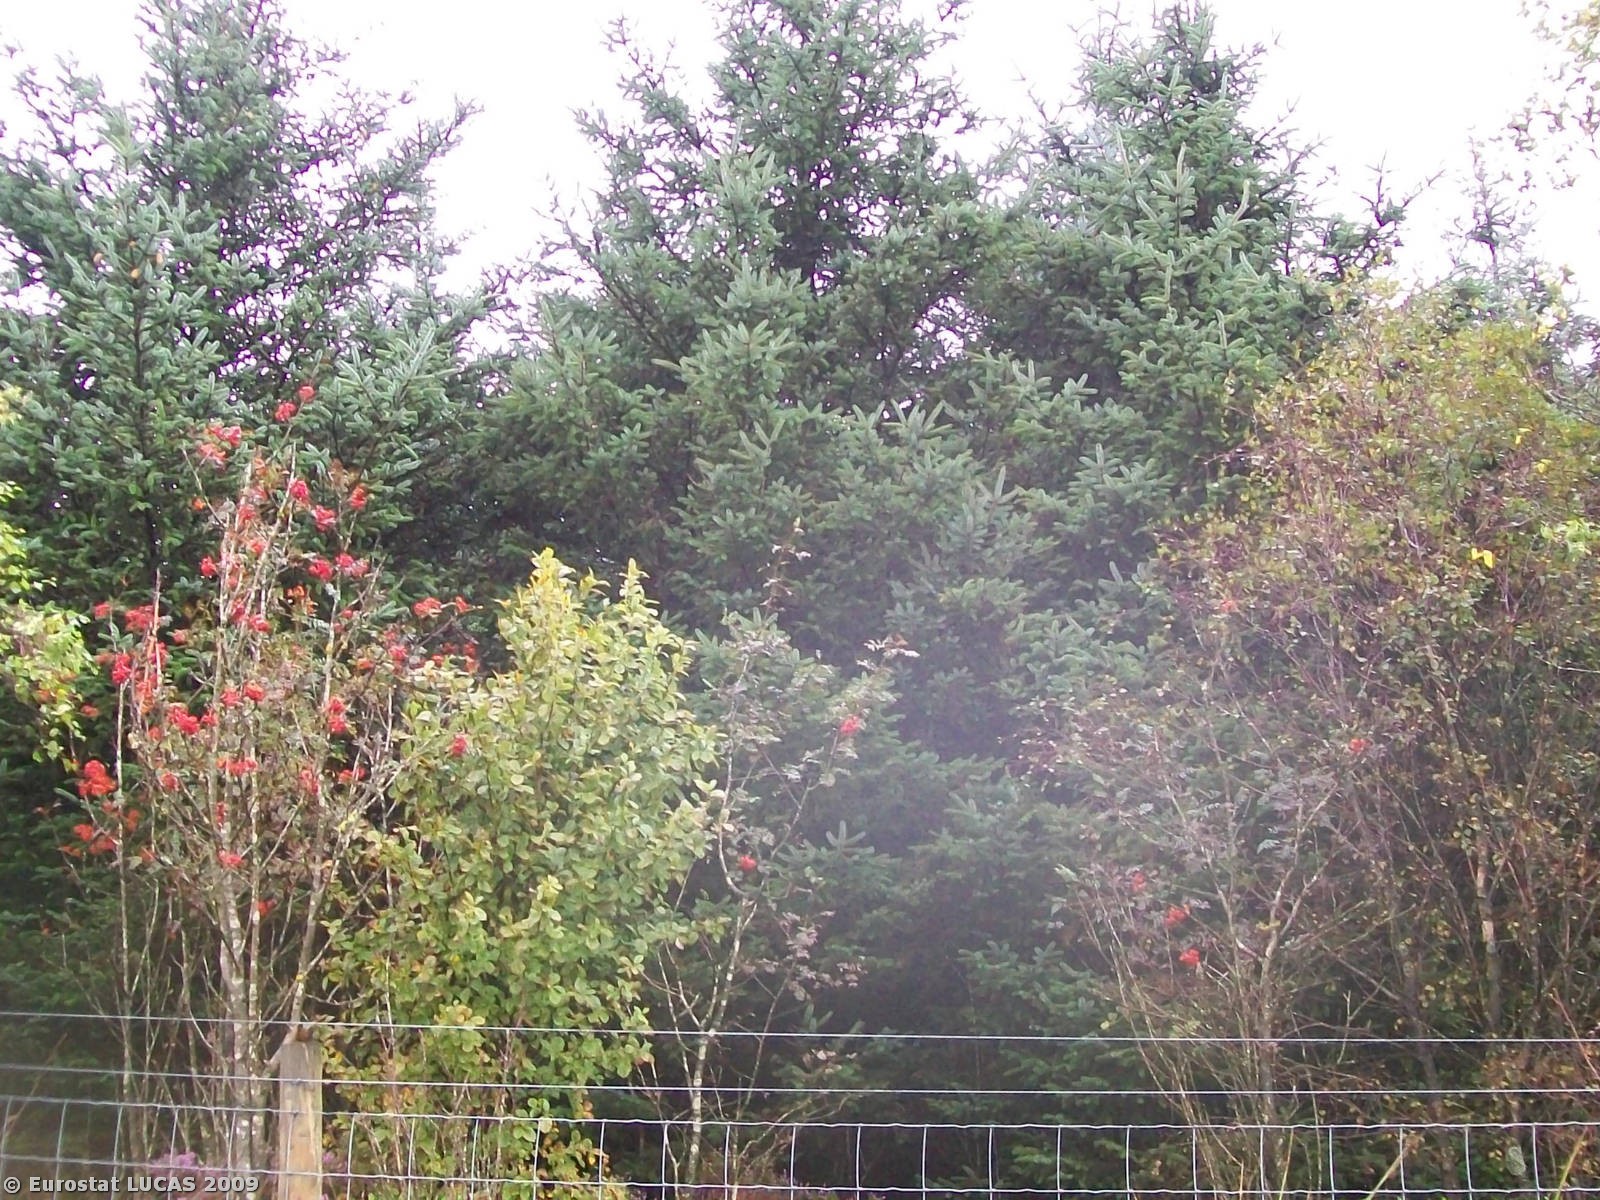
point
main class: Woodland
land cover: Coniferous woodland
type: plantations and self-sown exotic forest
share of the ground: > 75 %
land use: Forestry
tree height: > 5 m
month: August
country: GB
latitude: 54.3382
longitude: -3.1648
